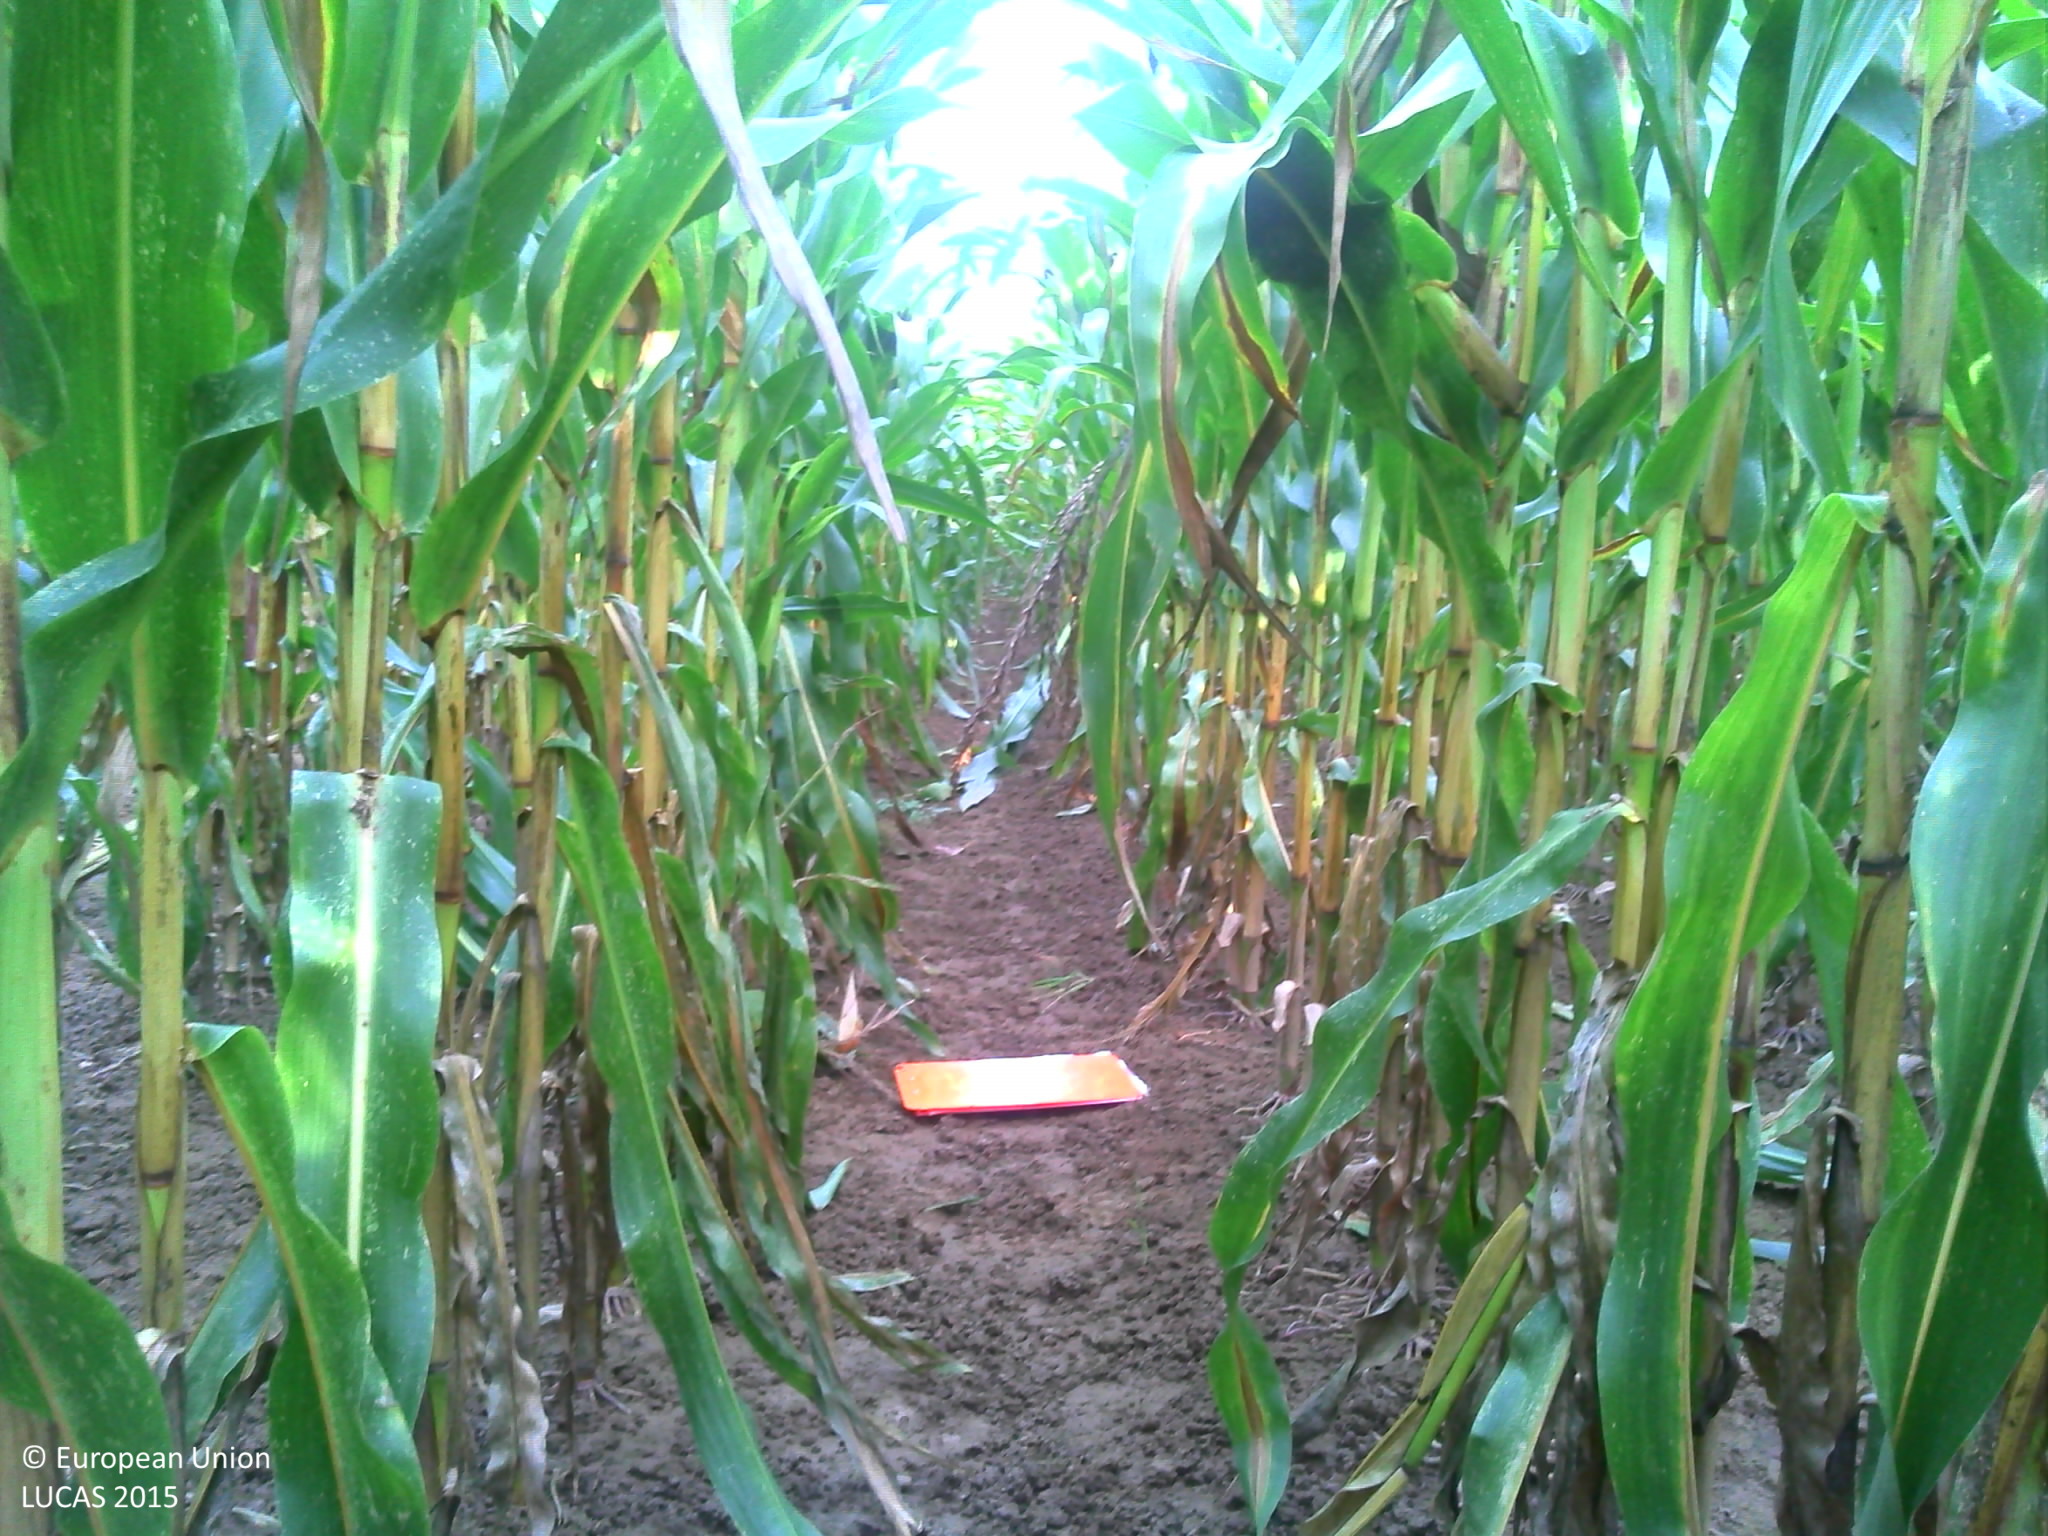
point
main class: Cropland
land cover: Maize
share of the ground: > 75 %
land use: Agriculture (excluding fallow land and kitchen gardens)
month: September
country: FR
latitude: 48.5026
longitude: 6.8471
